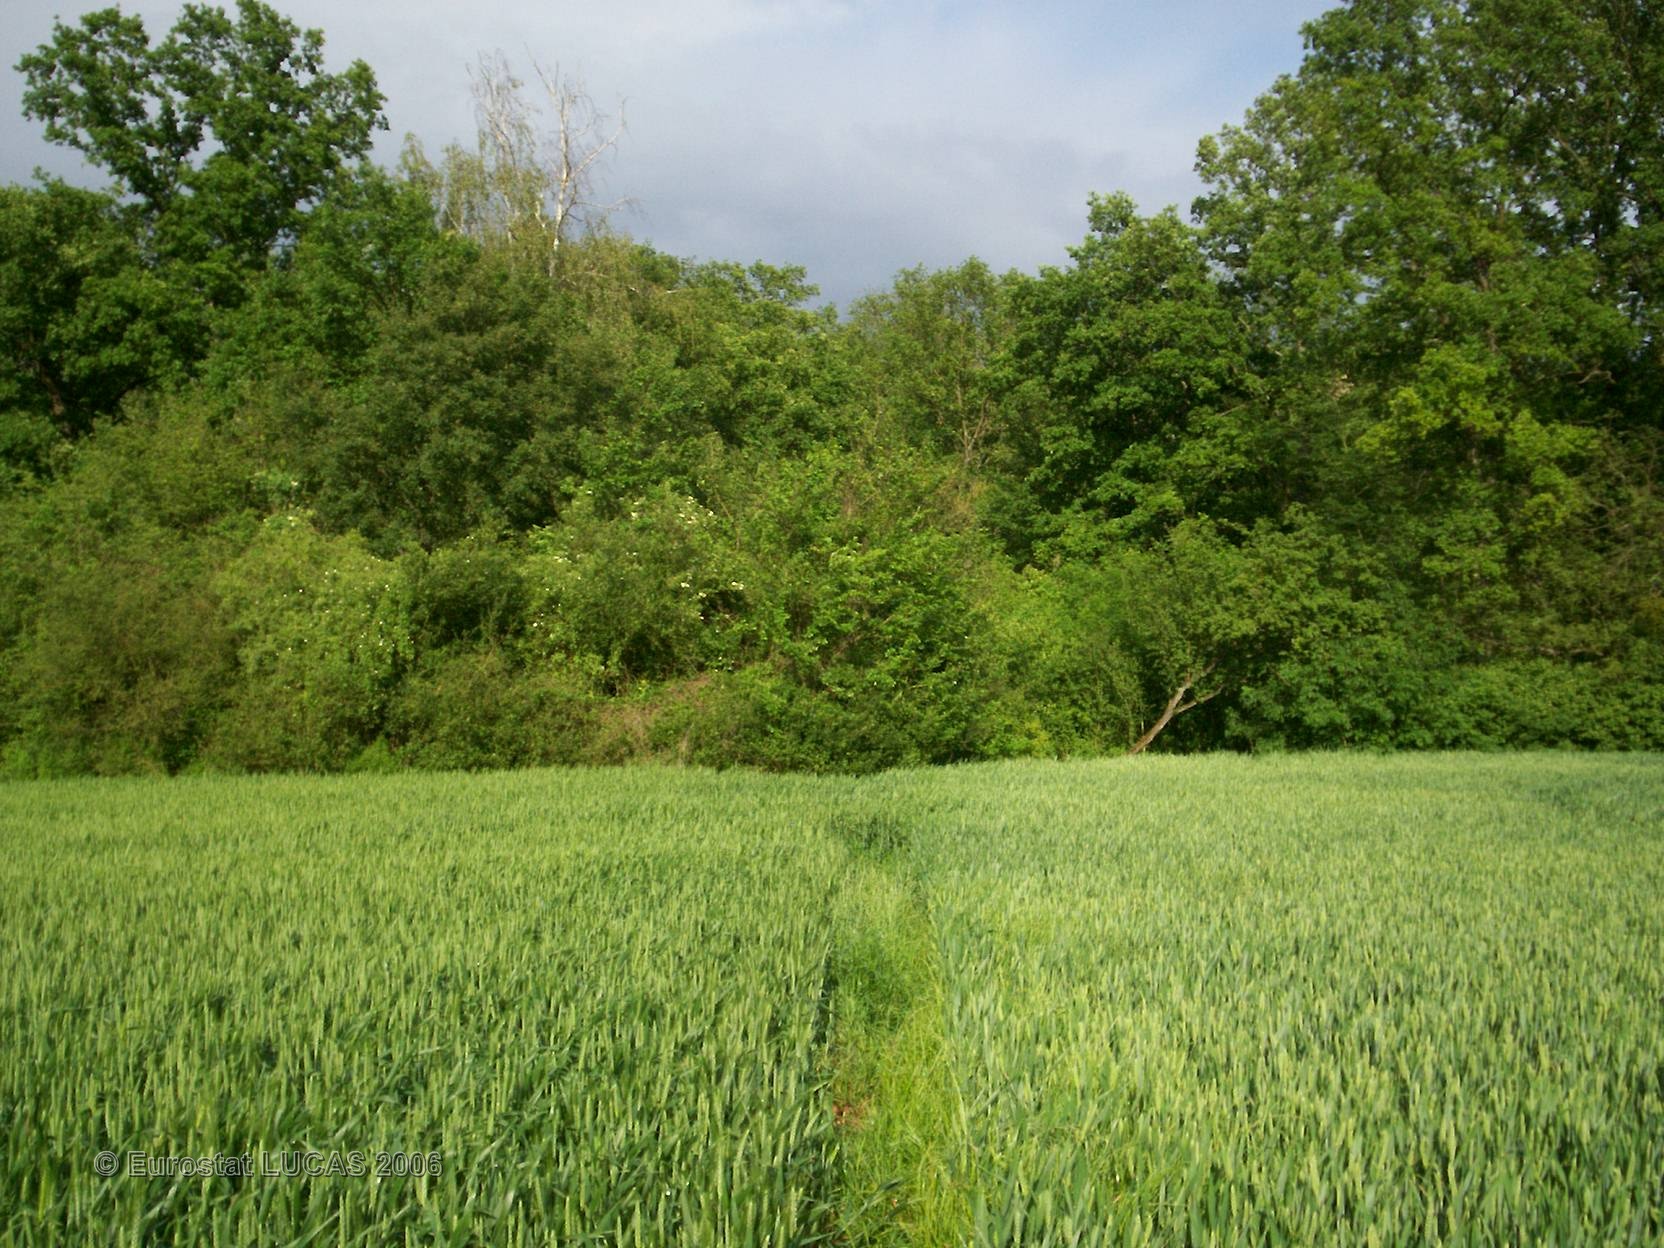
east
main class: Cropland
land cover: Common wheat
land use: Agriculture (excluding fallow land and kitchen gardens)
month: May
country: FR
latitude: 48.9074
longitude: 2.7727
